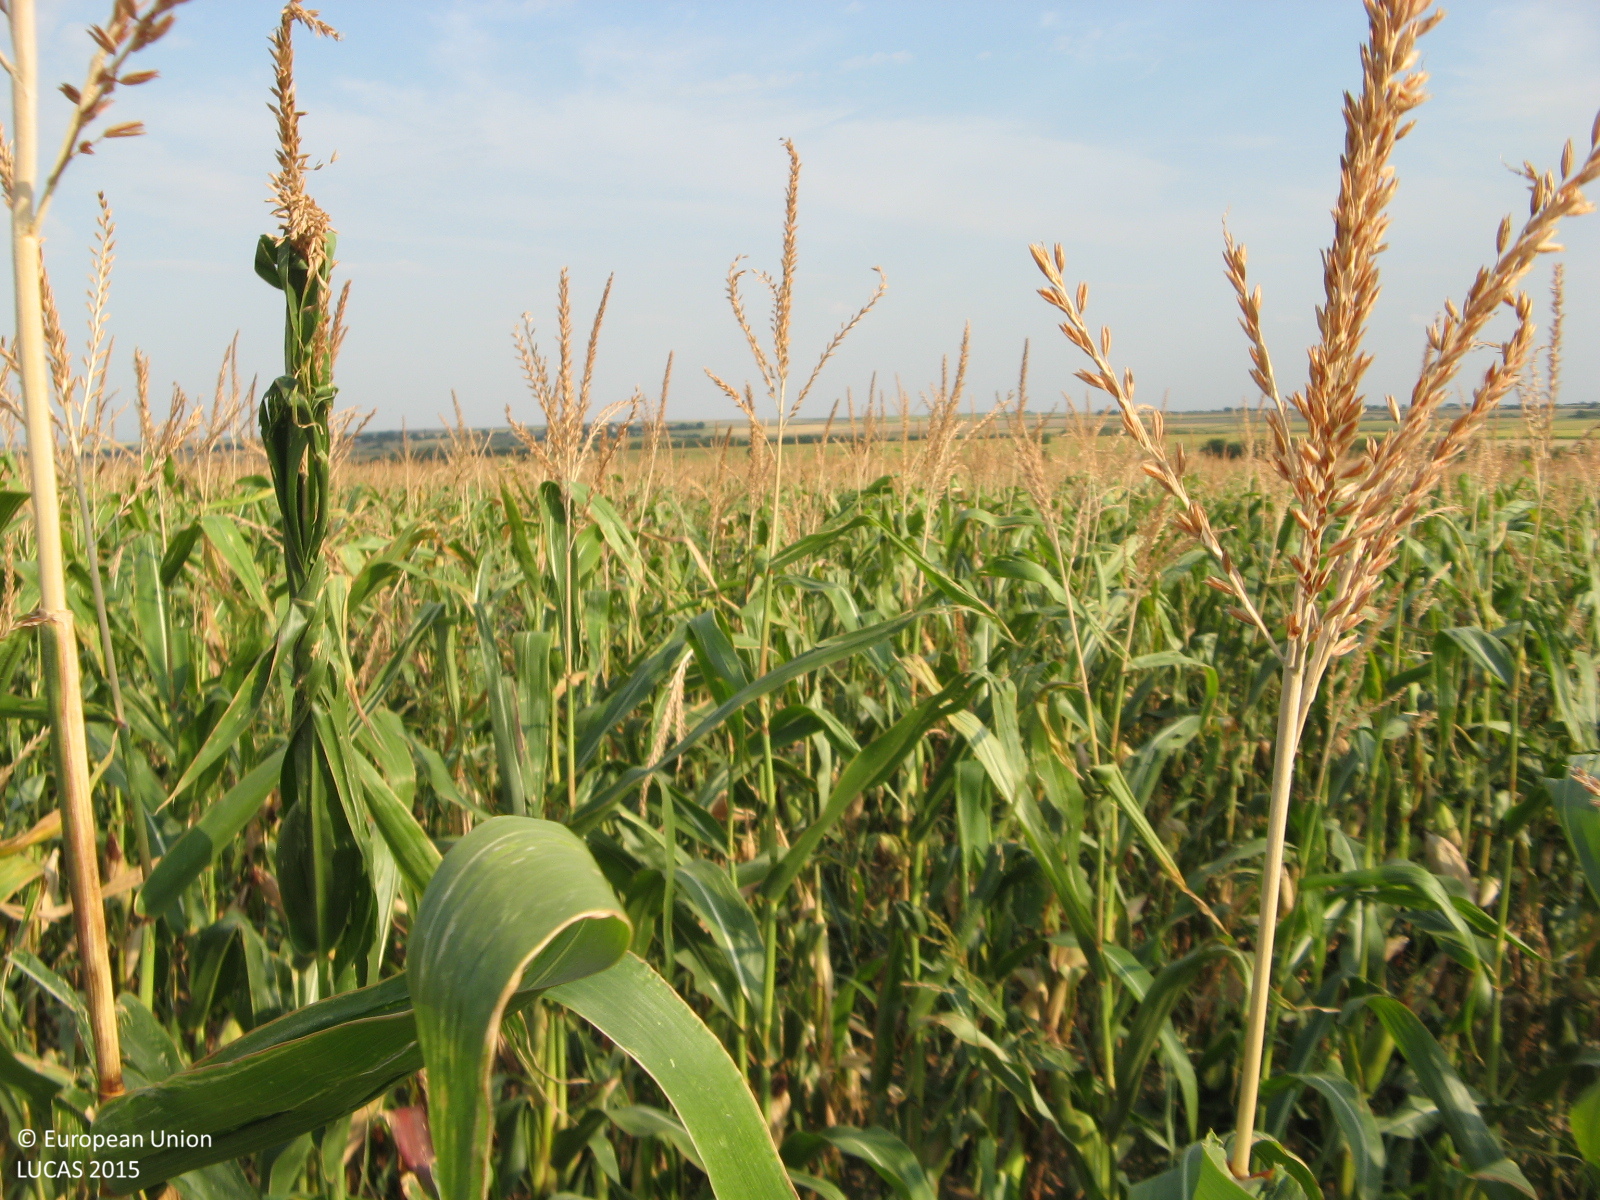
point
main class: Cropland
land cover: Maize
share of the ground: > 75 %
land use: Agriculture (excluding fallow land and kitchen gardens)
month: August
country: BG
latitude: 43.5611
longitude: 25.2675
